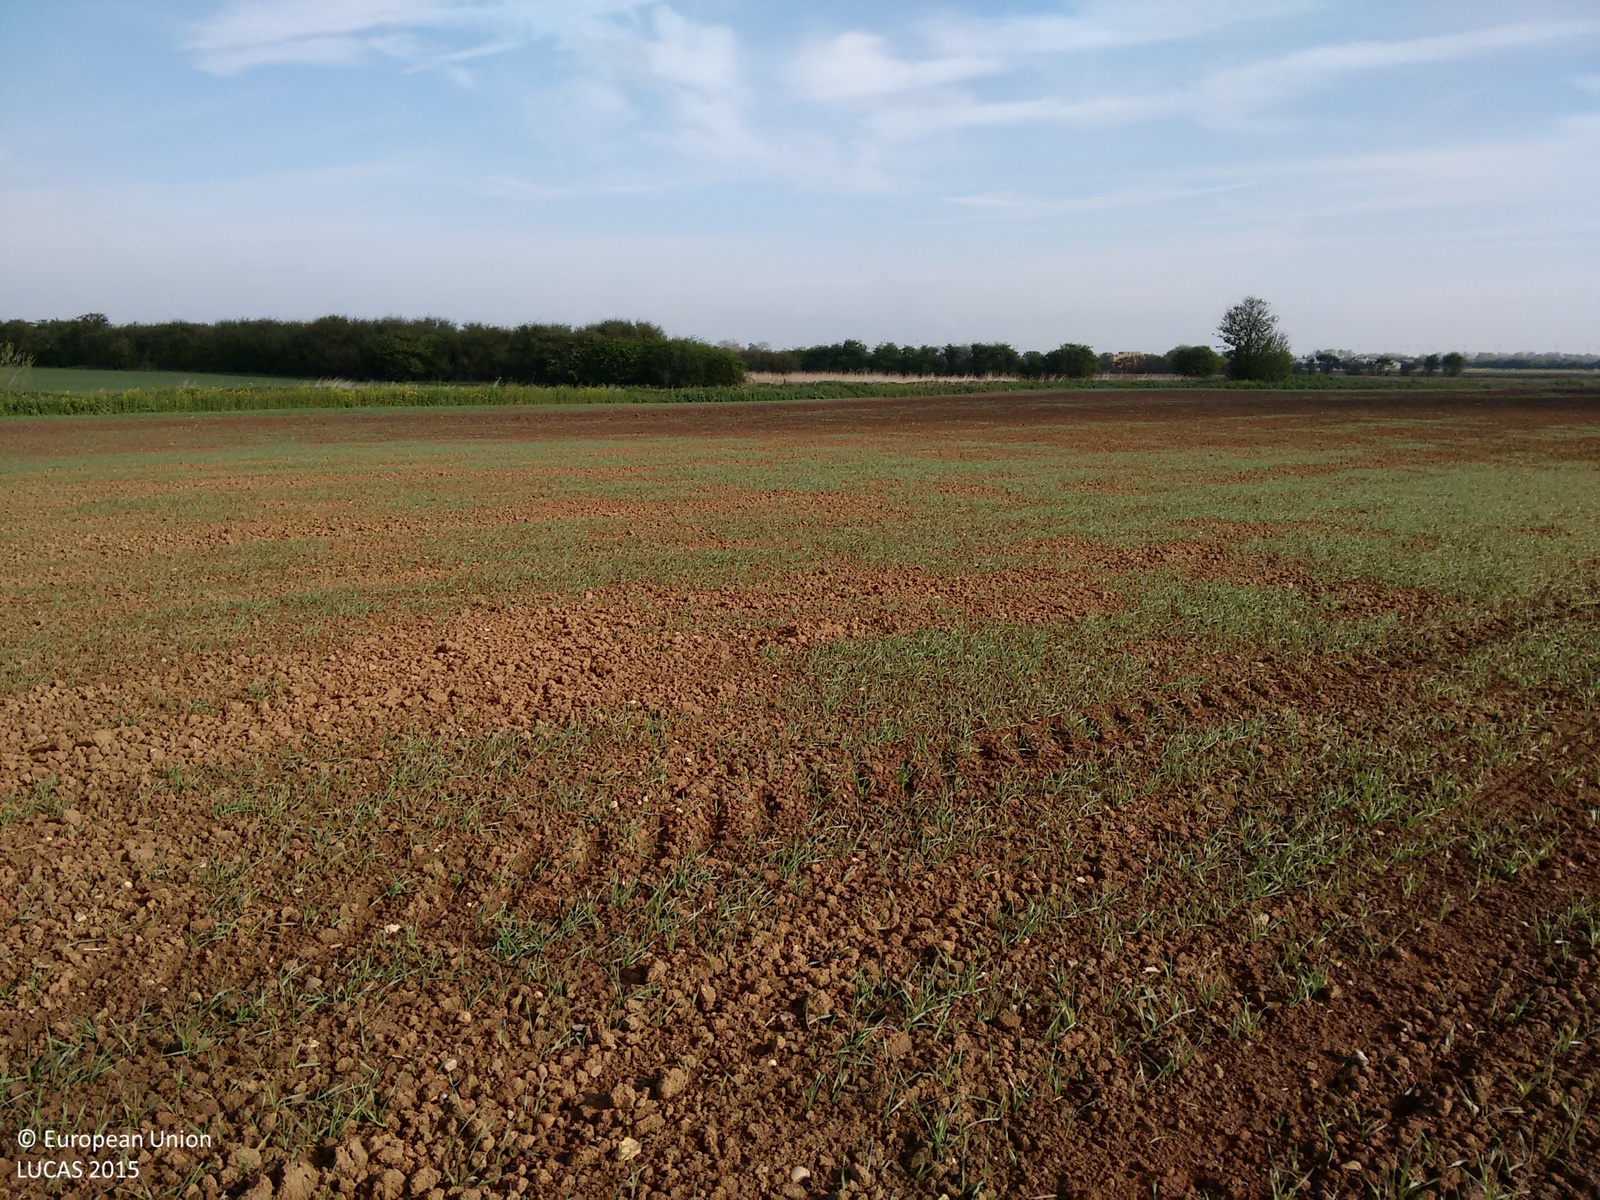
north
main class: Cropland
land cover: Barley
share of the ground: < 10 %
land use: Agriculture (excluding fallow land and kitchen gardens)
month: May
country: GB
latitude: 53.2759
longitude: 0.2075
